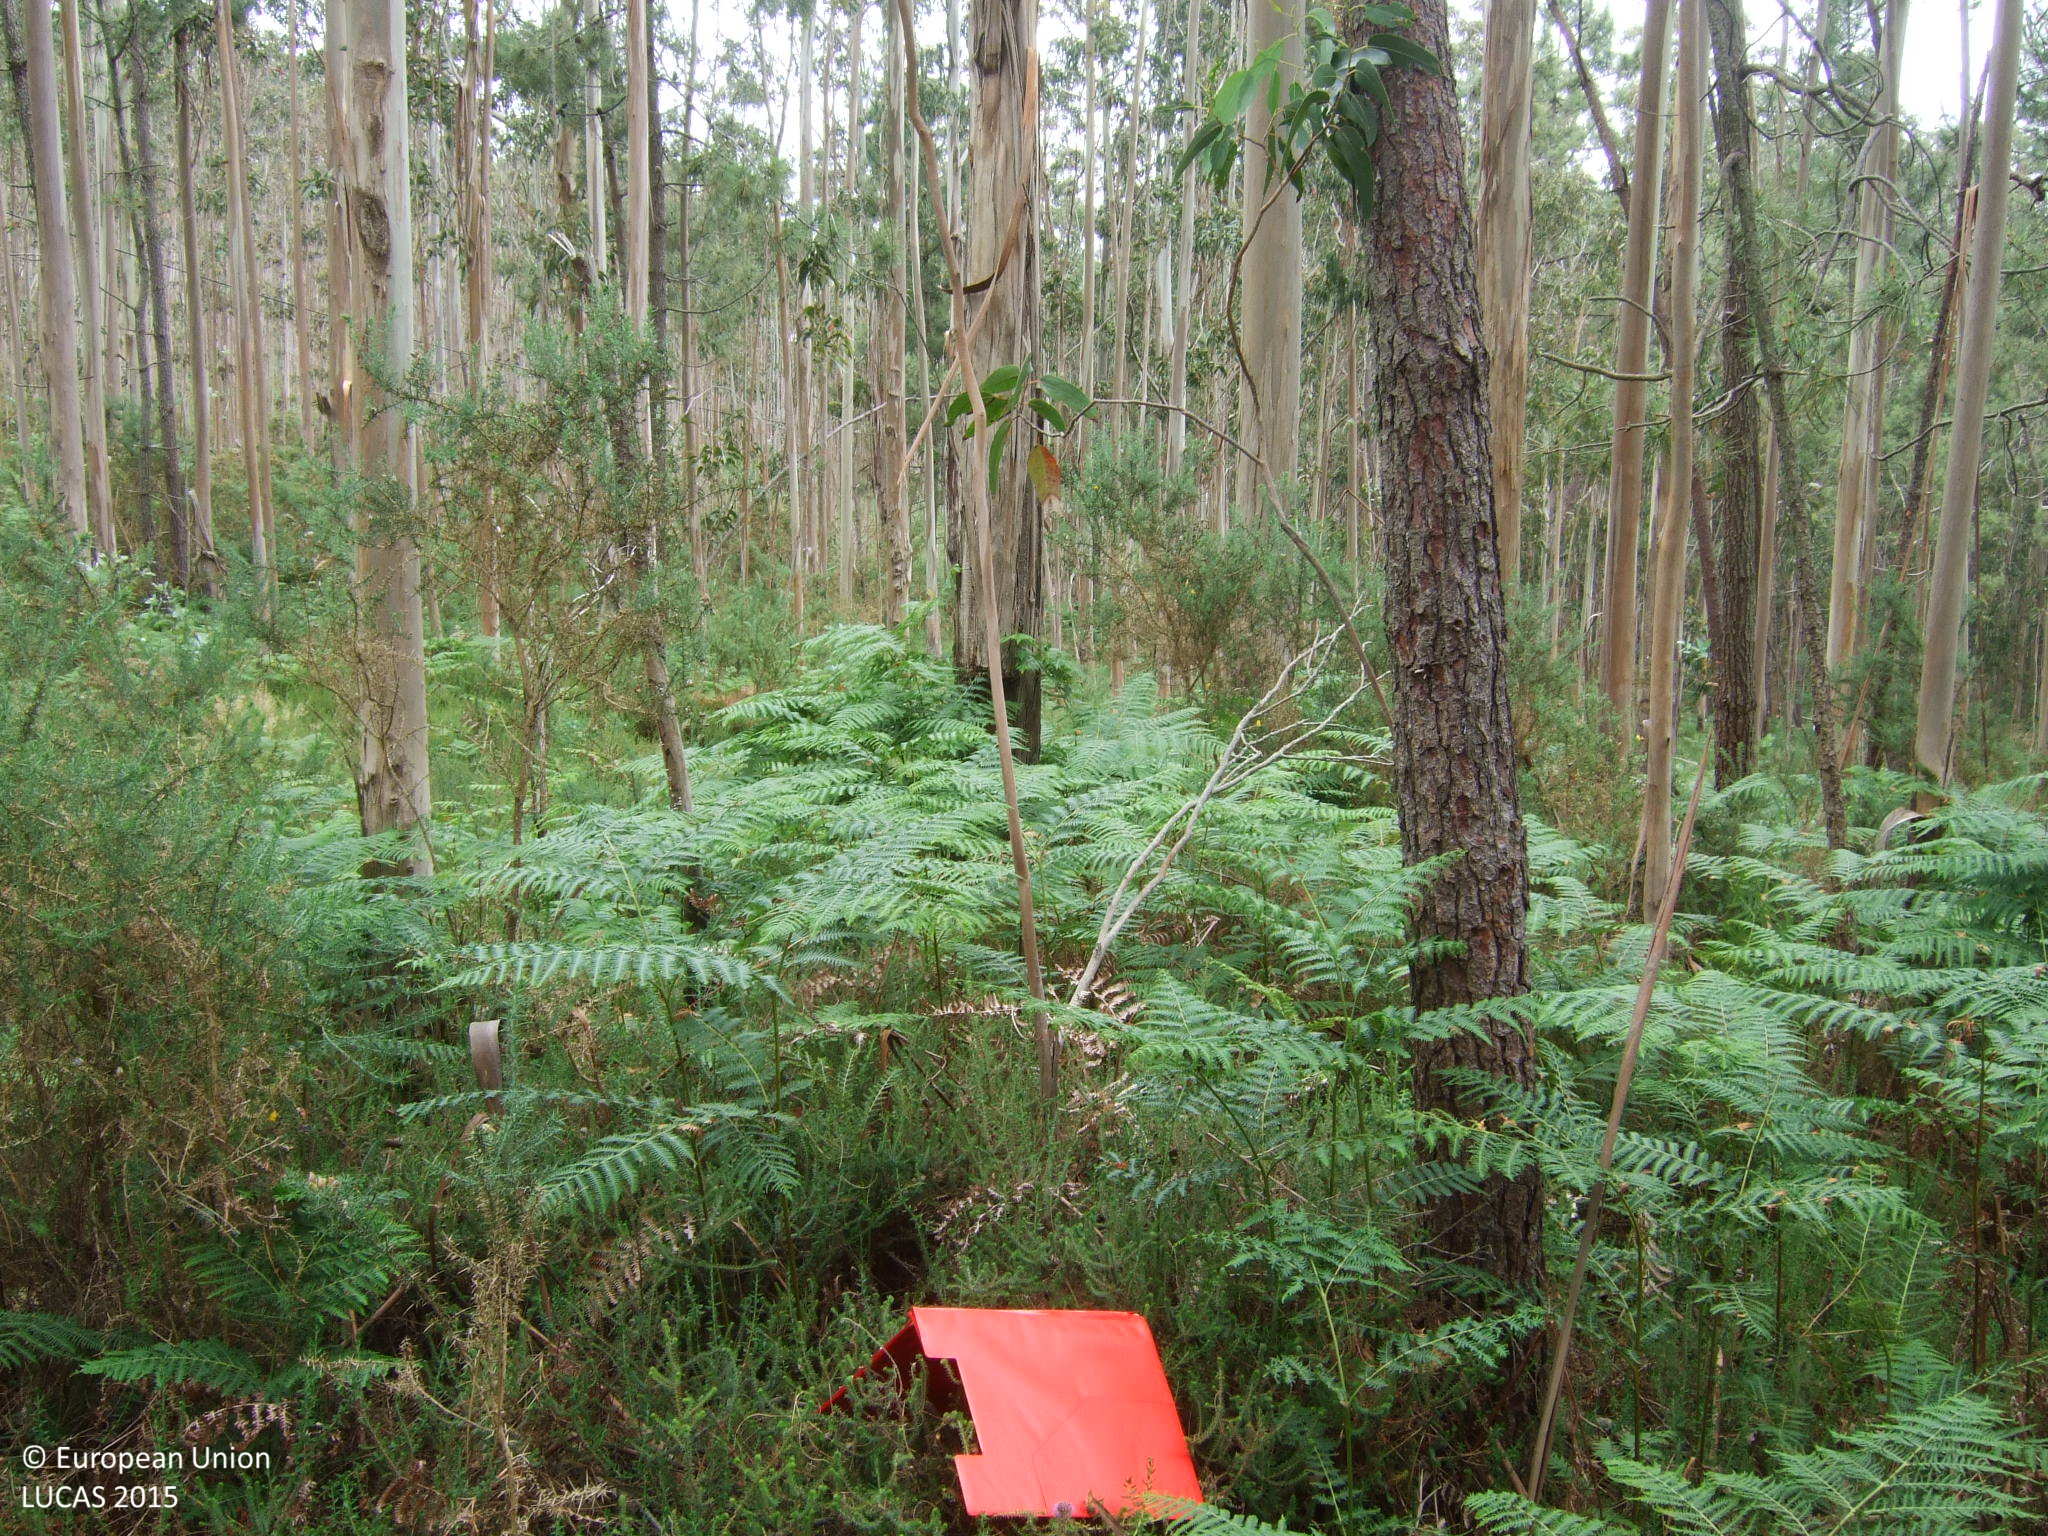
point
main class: Woodland
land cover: Other mixed woodland
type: exotic forest
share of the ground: 50 - 75 %
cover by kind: shrubs 45 %, broadleaved forest trees 30 %, coniferous forest trees 25 %
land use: Forestry
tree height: > 5 m
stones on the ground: < 10 %
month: June
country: ES
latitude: 43.6998
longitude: -7.7994
